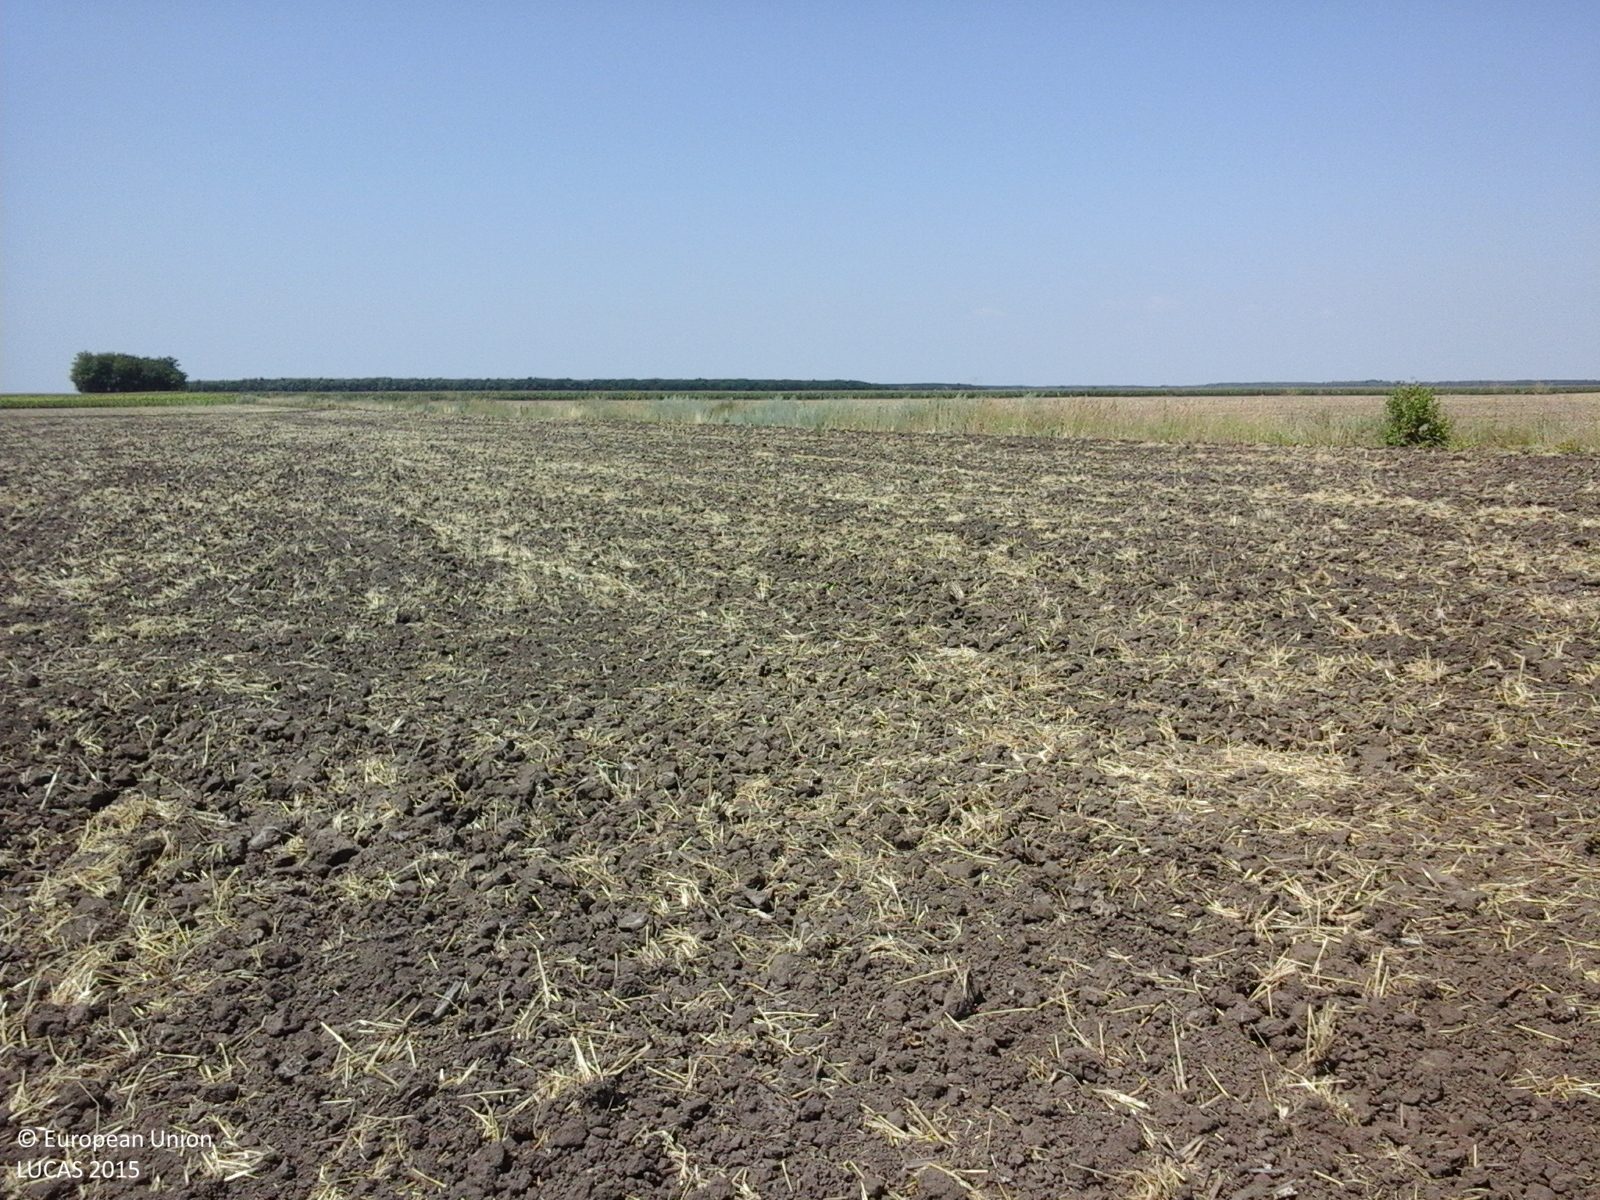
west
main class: Cropland
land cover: Common wheat
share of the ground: < 10 %
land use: Agriculture (excluding fallow land and kitchen gardens)
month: July
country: RO
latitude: 44.2347
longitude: 27.0420
